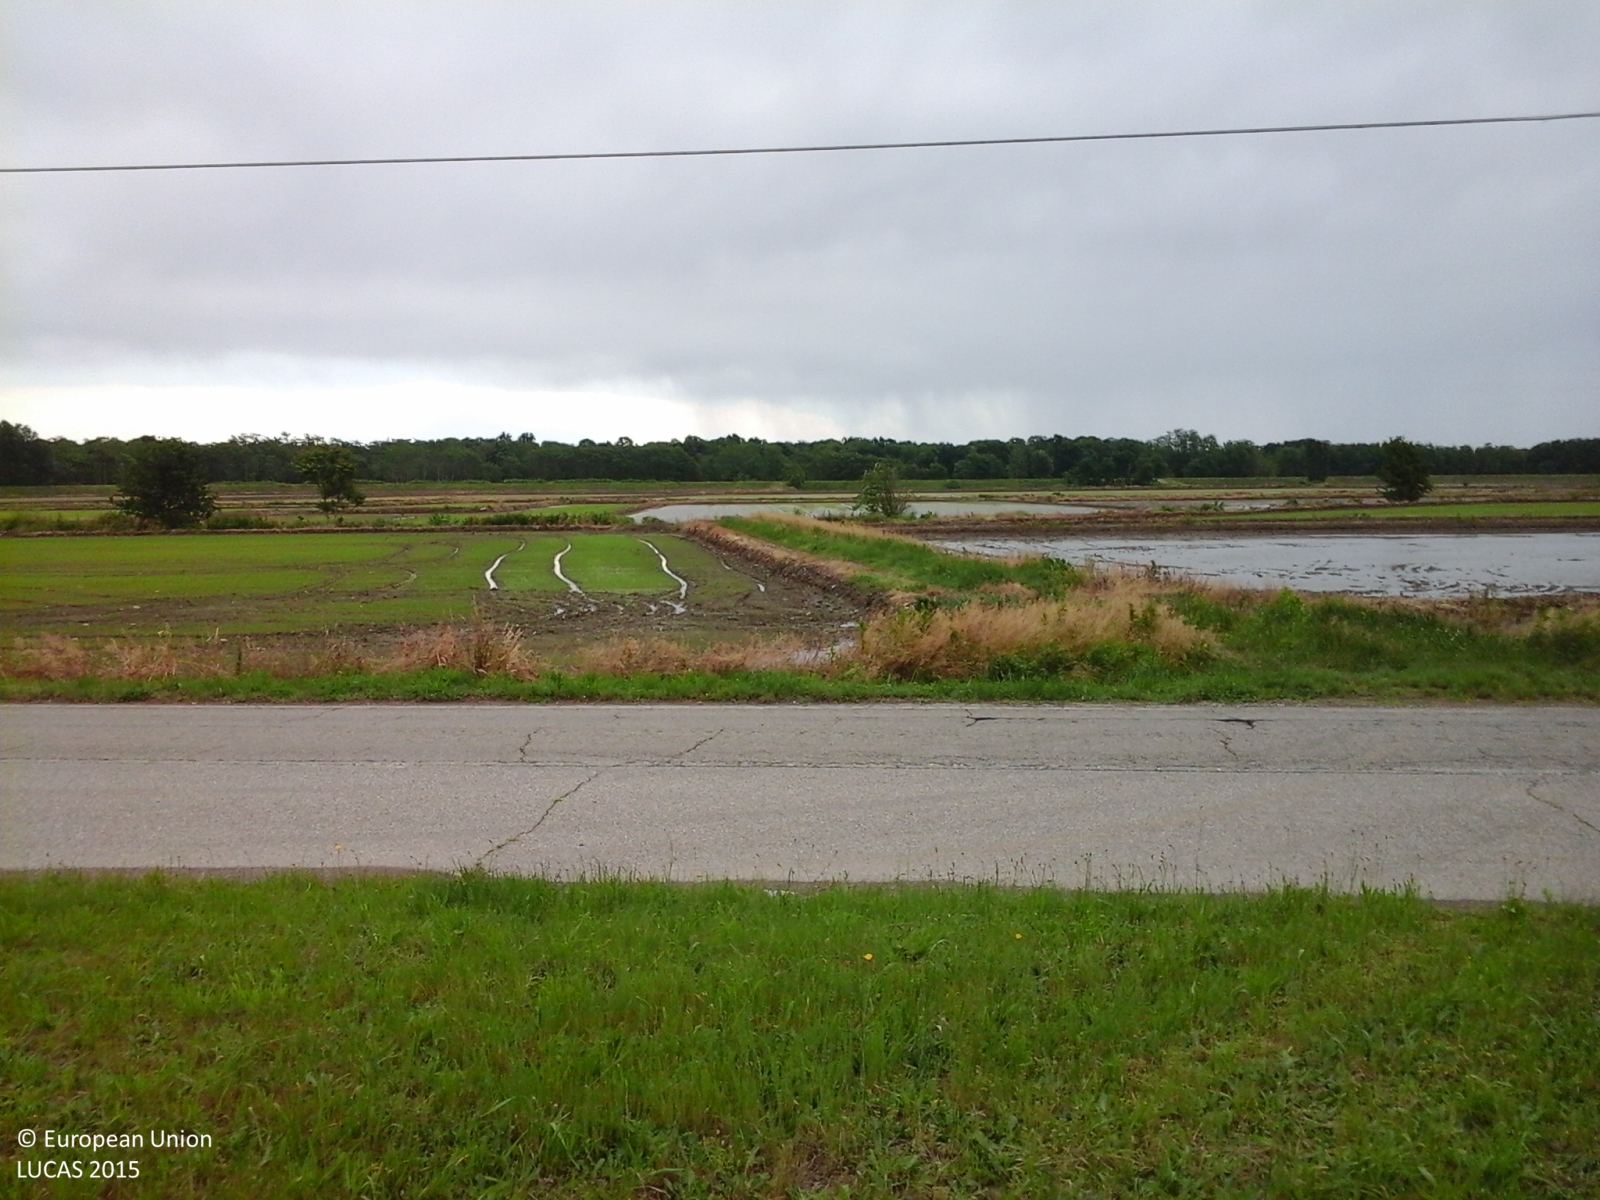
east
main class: Grassland
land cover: Grassland without tree/shrub cover
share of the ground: > 75 %
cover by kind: herbaceous plants 85 %, consolidated bare surface 15 %
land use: Road transport
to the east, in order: Grassland without tree/shrub cover; Paved roads, cycling and walking lanes; Grass margins; Ditches and canals; Grass margins; Rice; Grass margins; Ditches and canals; Grass margins; Ditches and canals; Grass margins; Rice; Other structural elements; Rice
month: May
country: IT
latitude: 45.4199
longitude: 8.3797
